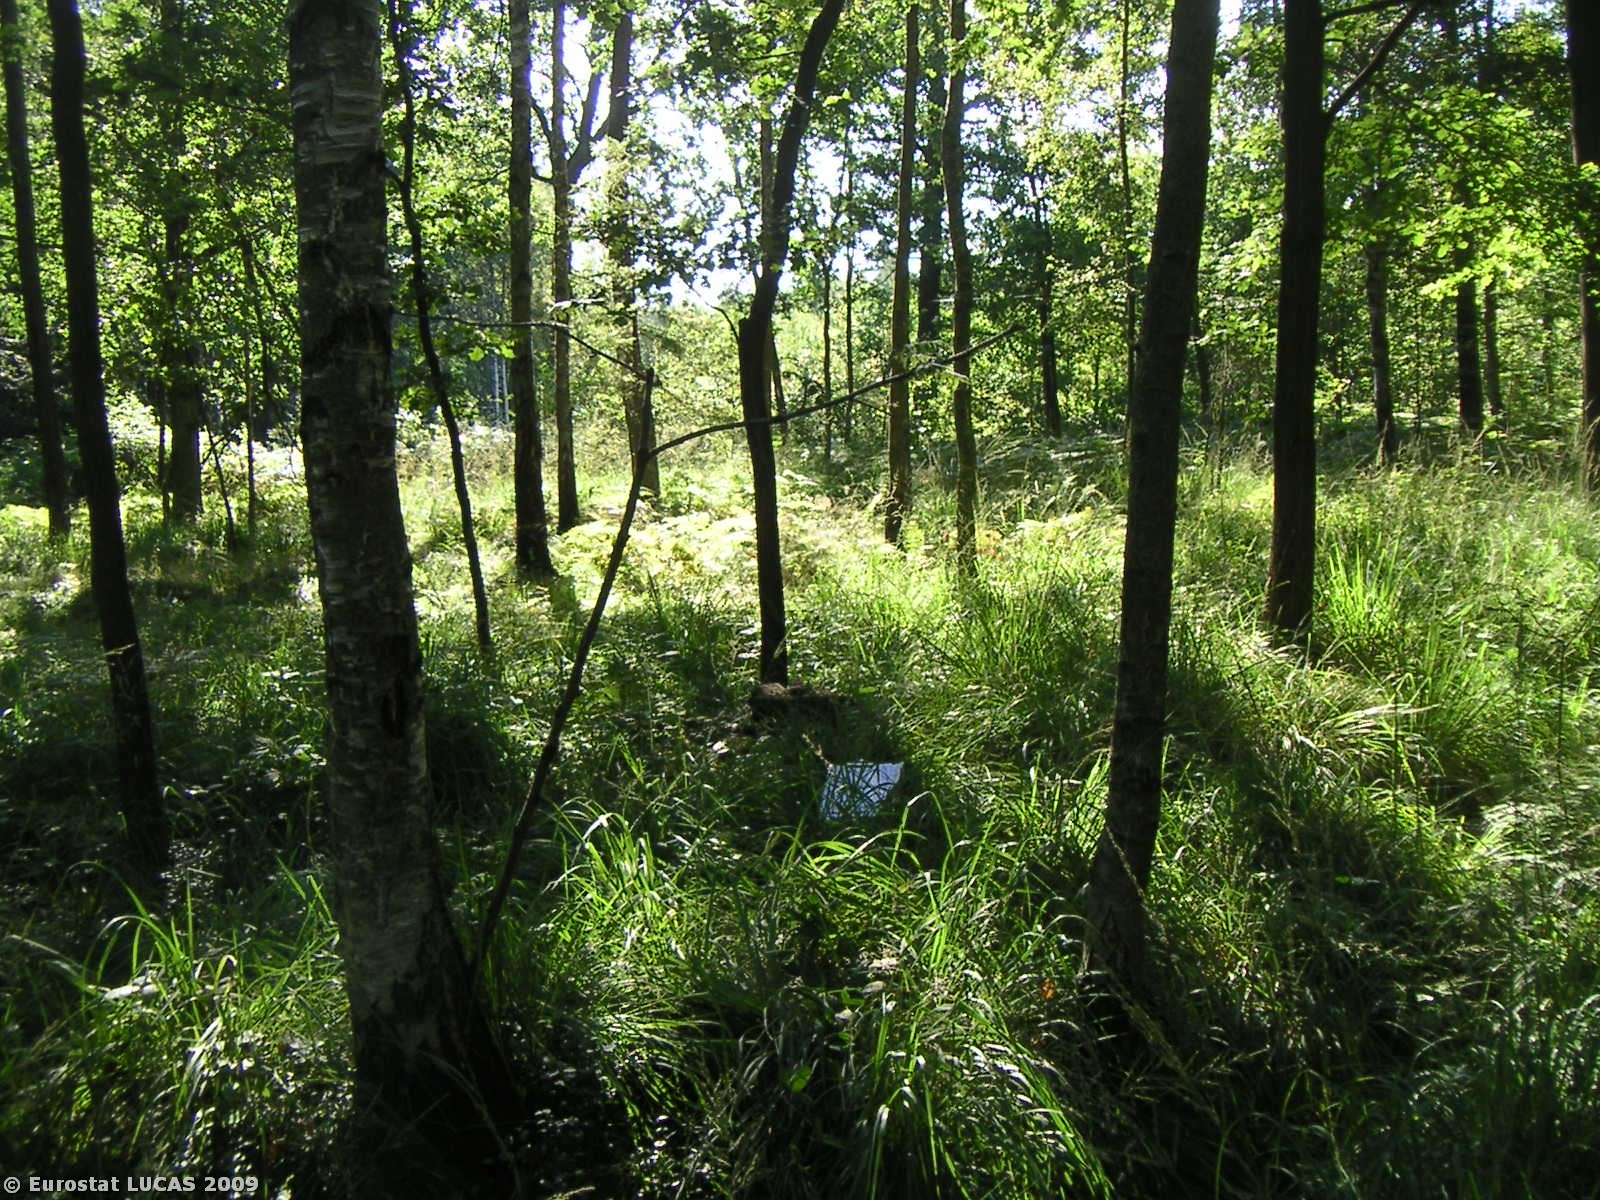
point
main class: Woodland
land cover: Mixed woodland
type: hemiboreal forest and nemoral coniferous forest and mixed broadleaved-coniferous forest
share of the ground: > 75 %
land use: Forestry
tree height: > 5 m
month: August
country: PL
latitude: 50.6527
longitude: 18.8622
